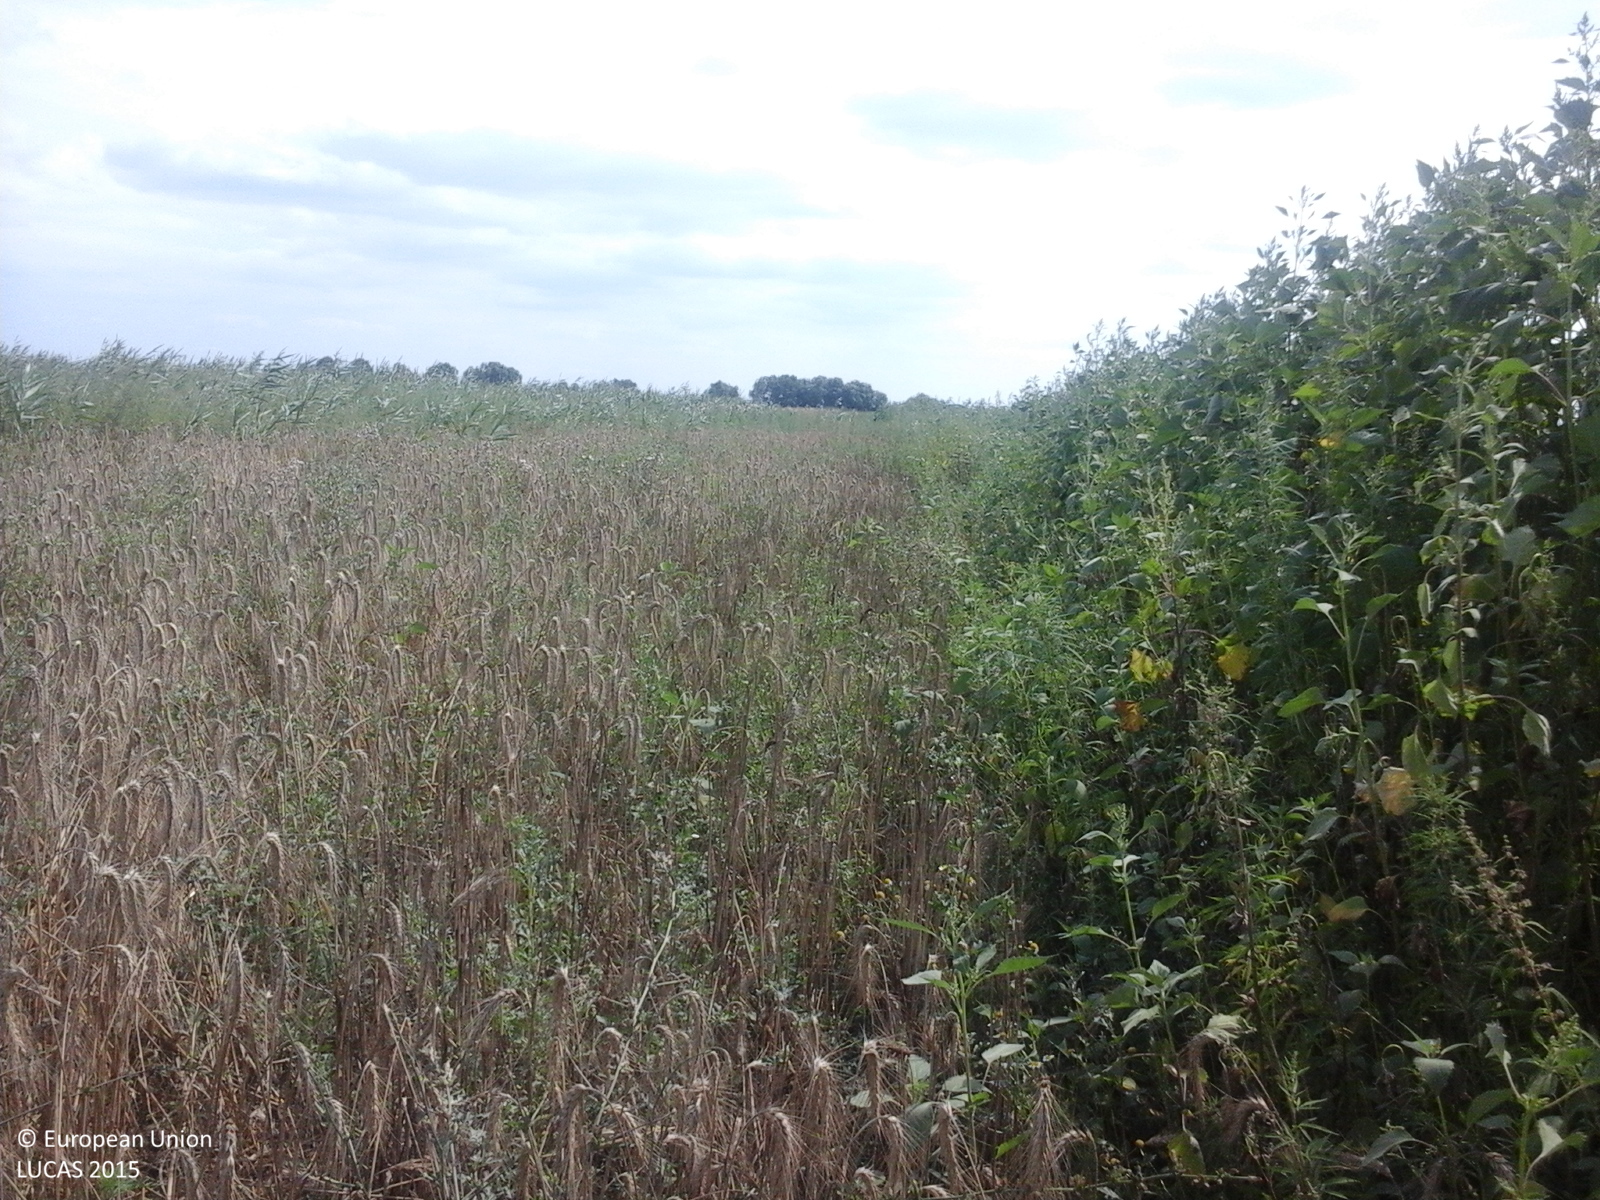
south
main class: Cropland
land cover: Barley
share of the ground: > 75 %
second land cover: Spontaneously vegetated surfaces
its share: > 75 %
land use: Agriculture (excluding fallow land and kitchen gardens)
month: August
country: RO
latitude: 45.2815
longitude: 29.1626
